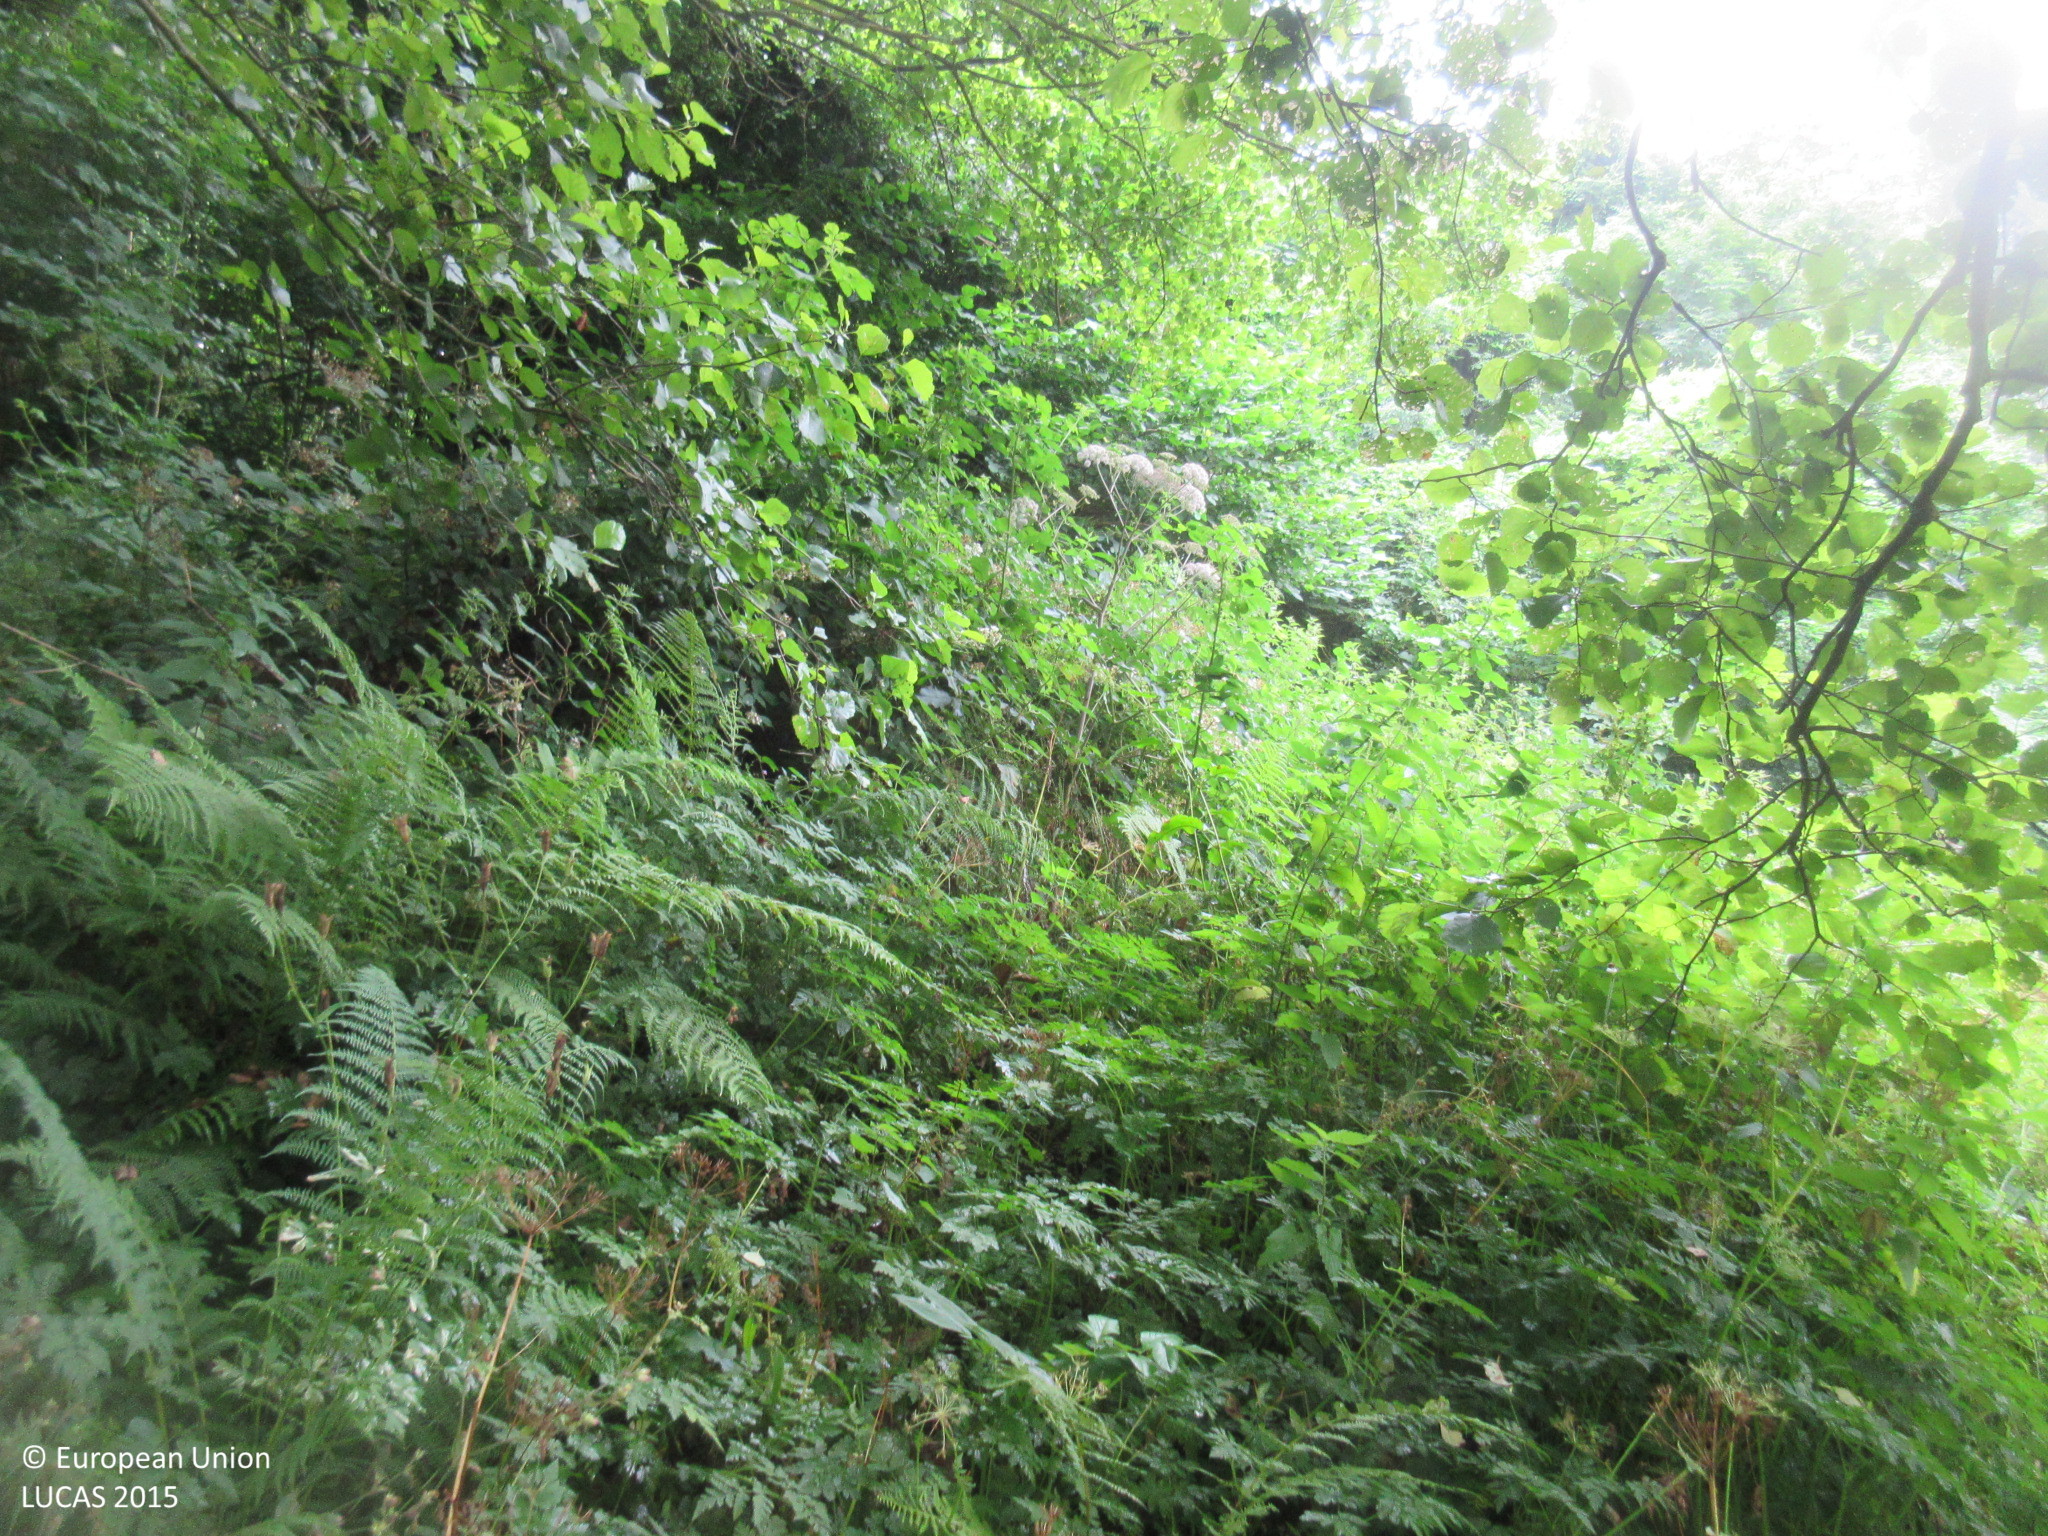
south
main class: Grassland
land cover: Grassland without tree/shrub cover
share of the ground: > 75 %
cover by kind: herbaceous plants 100 %
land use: Agriculture (excluding fallow land and kitchen gardens)
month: July
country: ES
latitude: 43.4338
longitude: -6.3203
